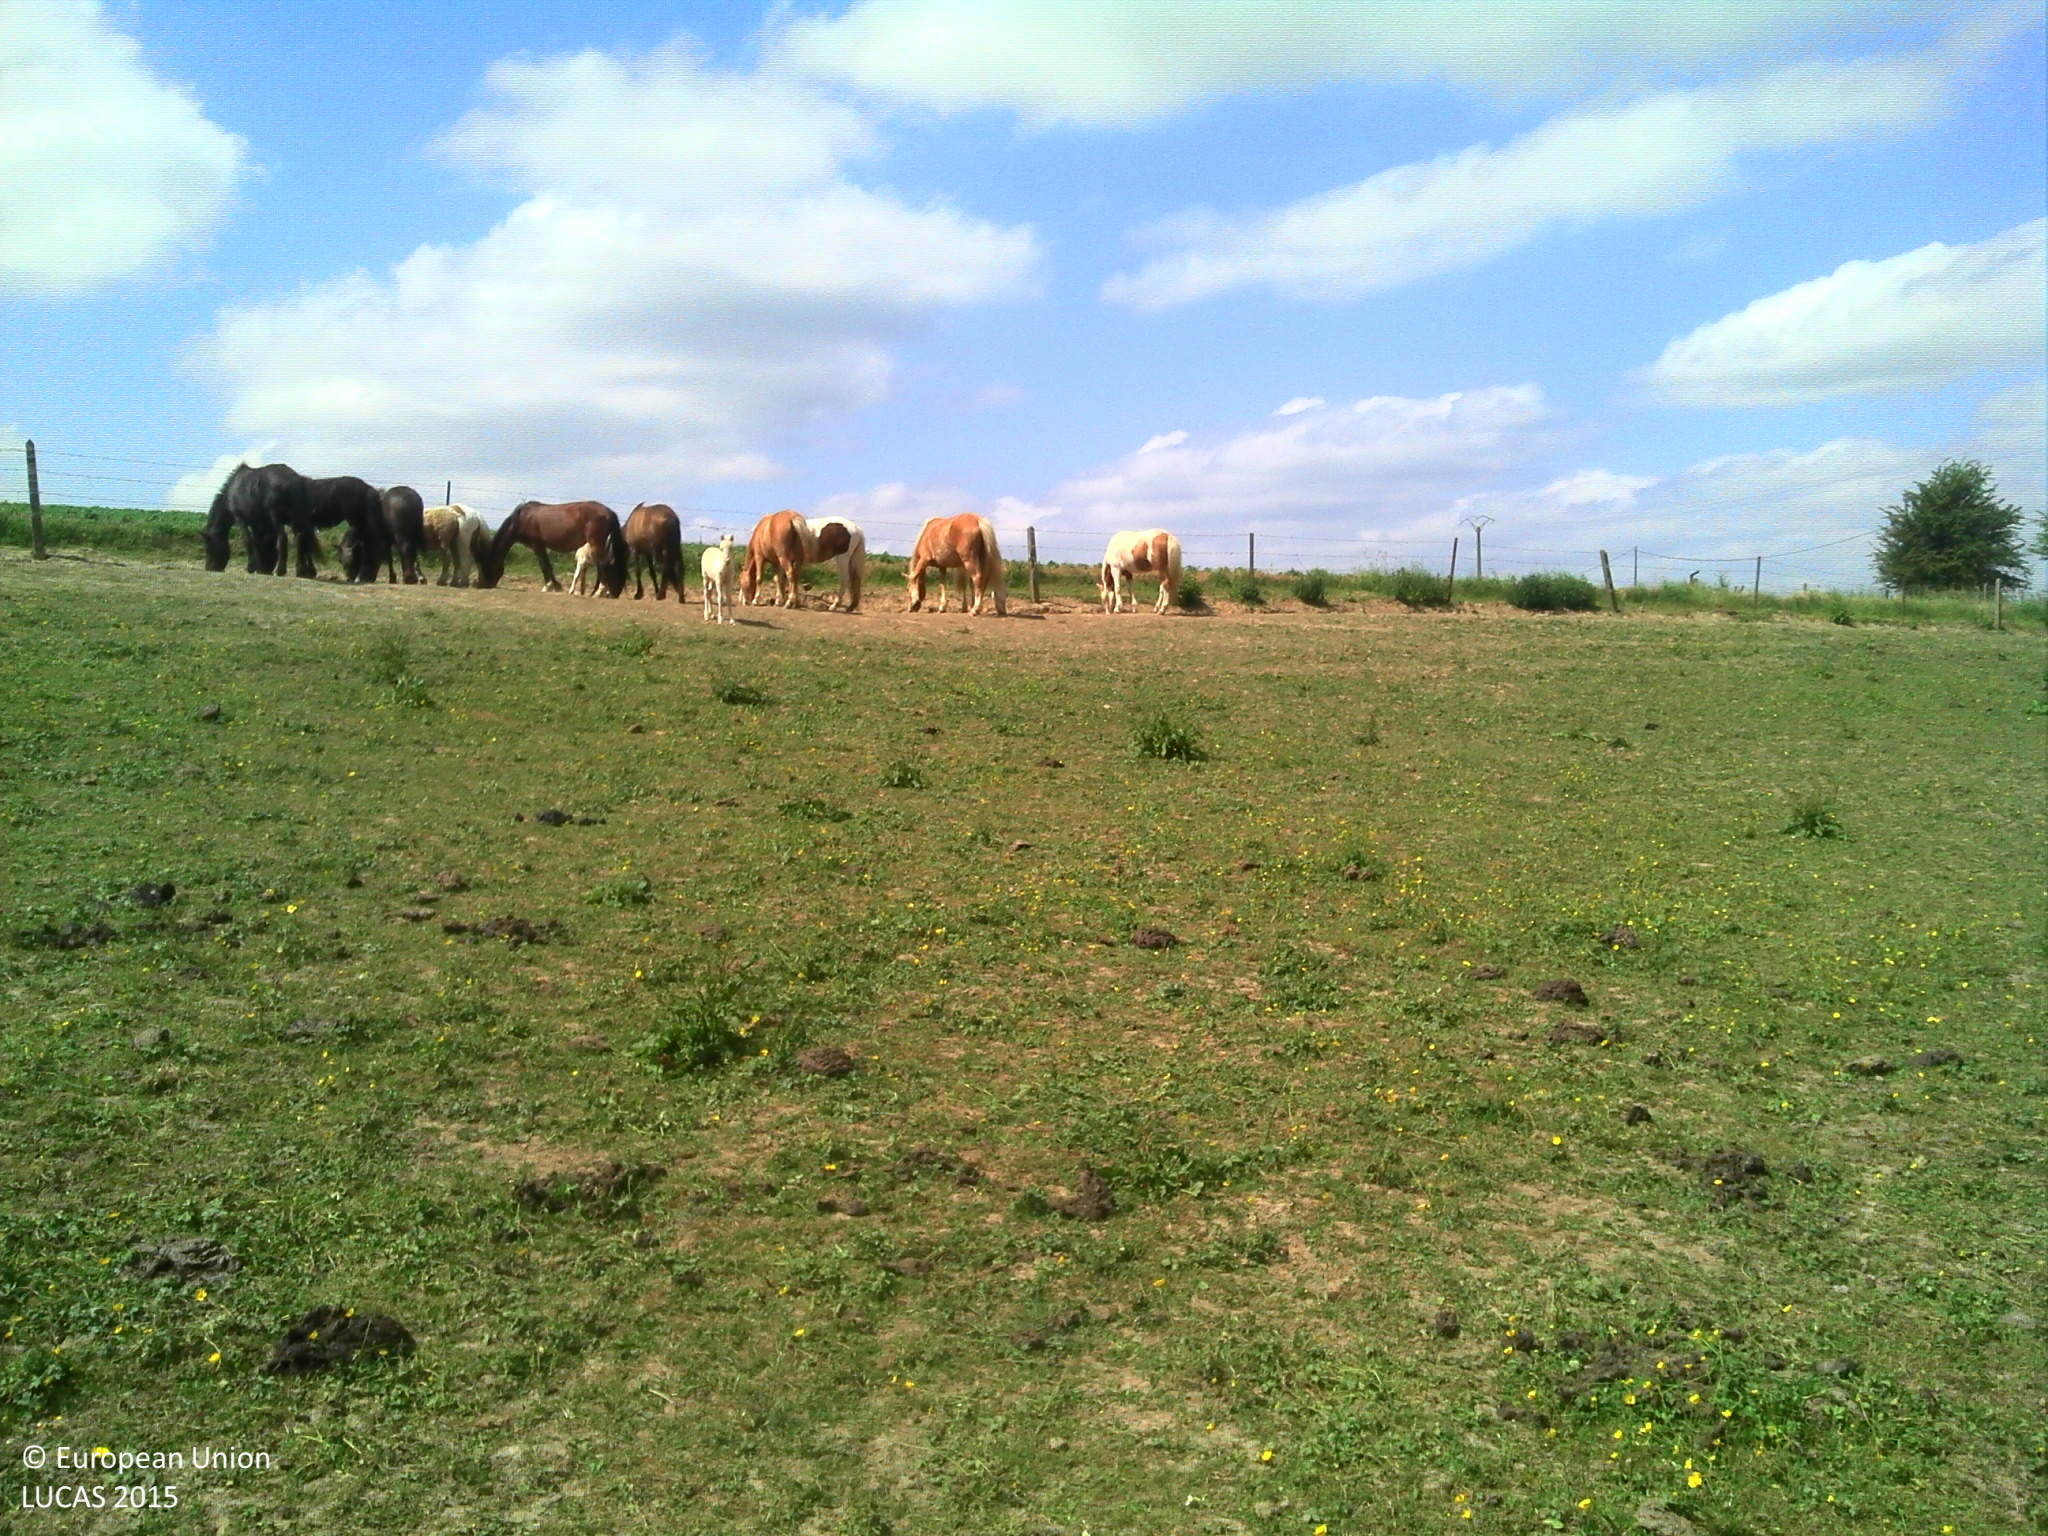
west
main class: Grassland
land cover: Grassland without tree/shrub cover
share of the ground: > 75 %
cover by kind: herbaceous plants 100 %
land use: Agriculture (excluding fallow land and kitchen gardens)
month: June
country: BE
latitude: 50.3812
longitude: 4.6101
